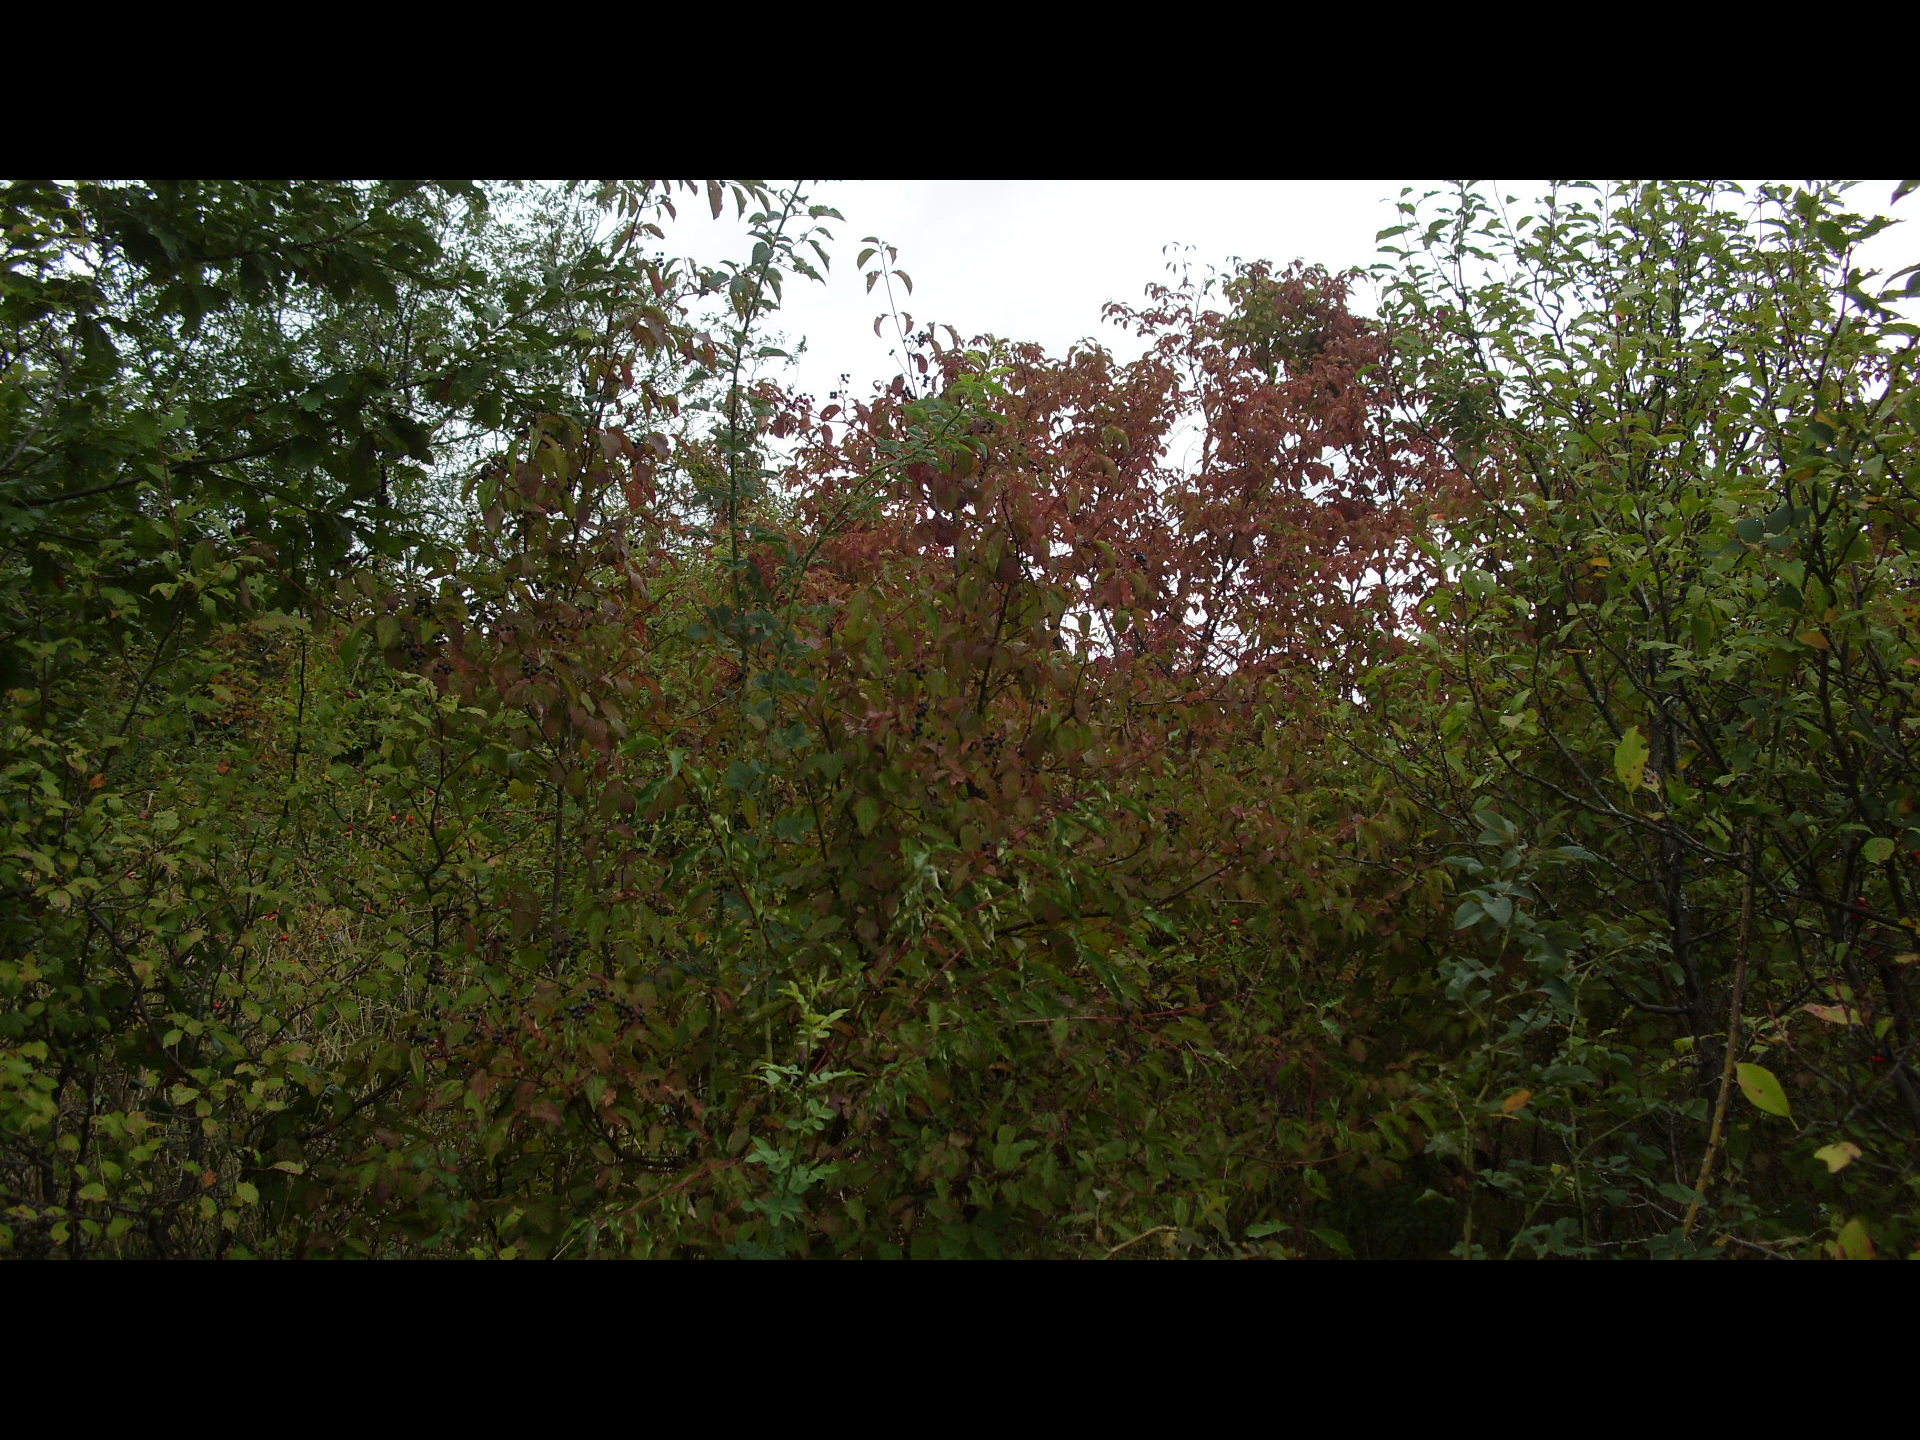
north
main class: Woodland
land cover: Broadleaved woodland
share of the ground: > 75 %
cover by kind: broadleaved forest trees 95 %, shrubs 5 %
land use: Semi-natural and natural areas not in use
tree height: < 5 m
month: September
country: BG
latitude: 43.2805
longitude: 23.0864
